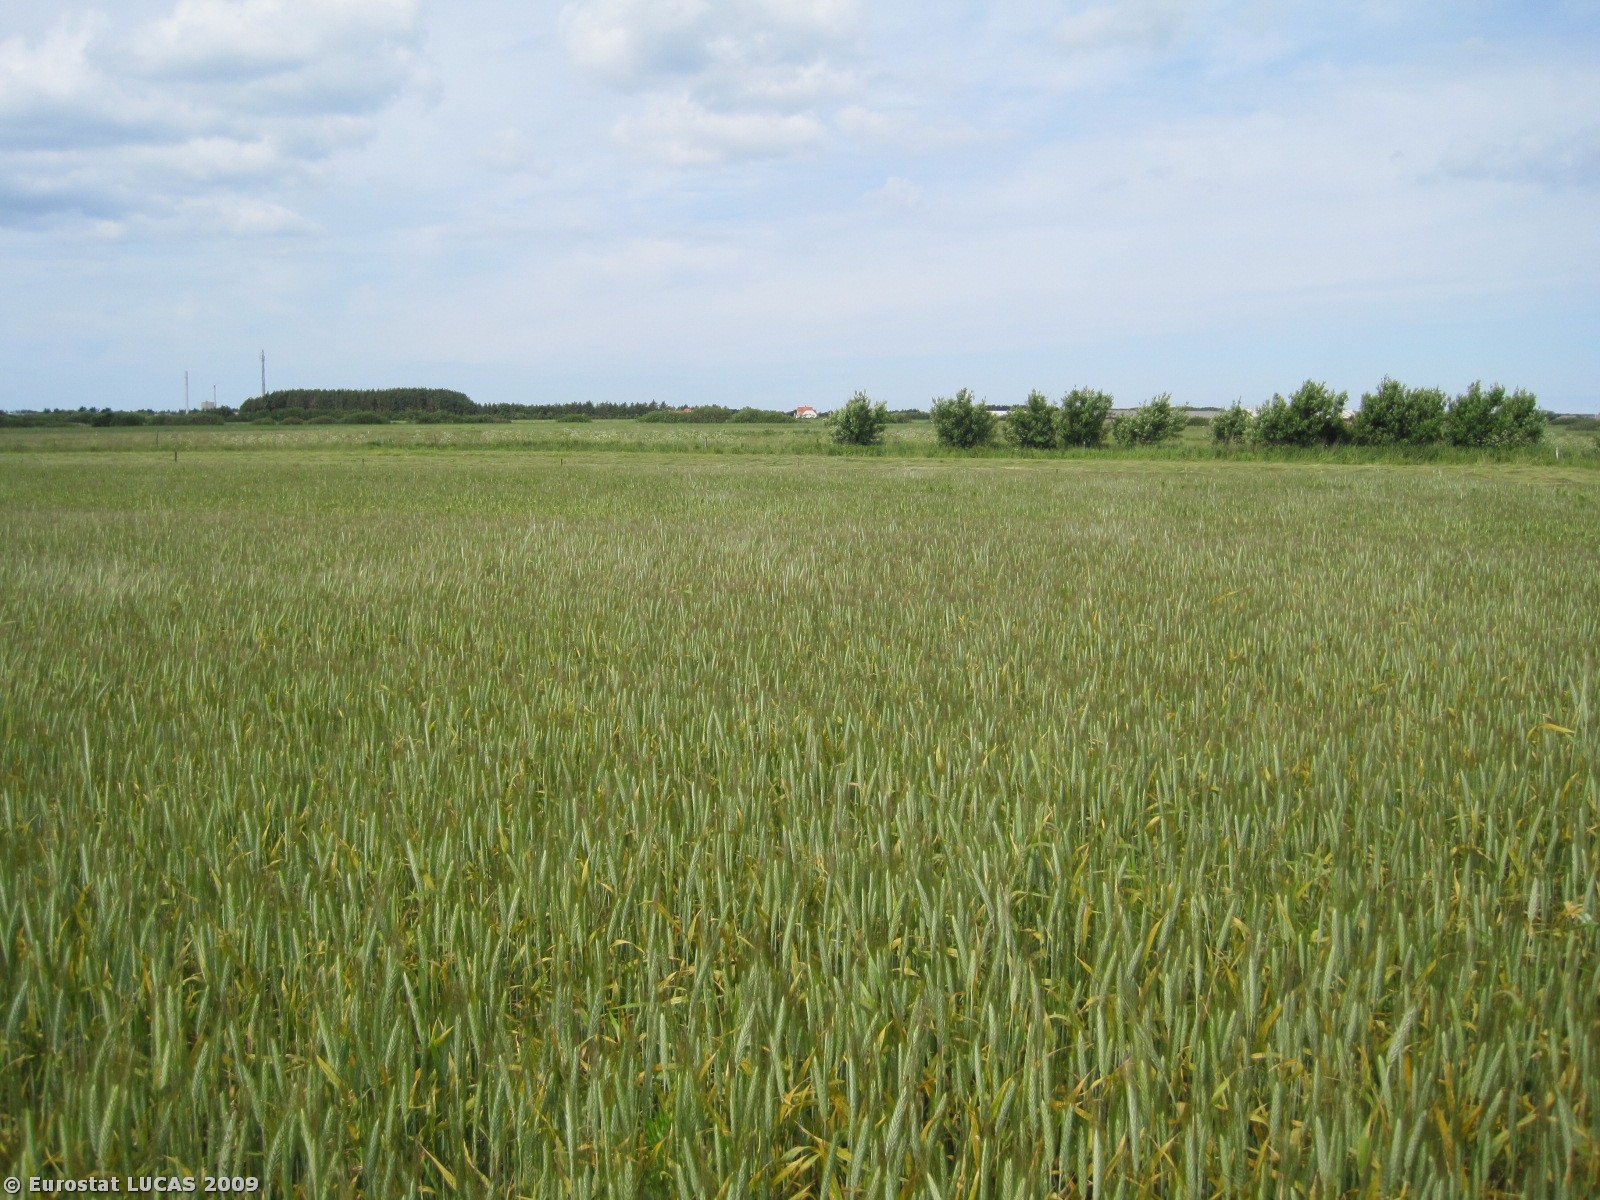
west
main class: Cropland
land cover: Barley
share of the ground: > 75 %
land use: Agriculture (excluding fallow land and kitchen gardens)
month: June
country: DK
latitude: 57.3740
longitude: 9.7510
